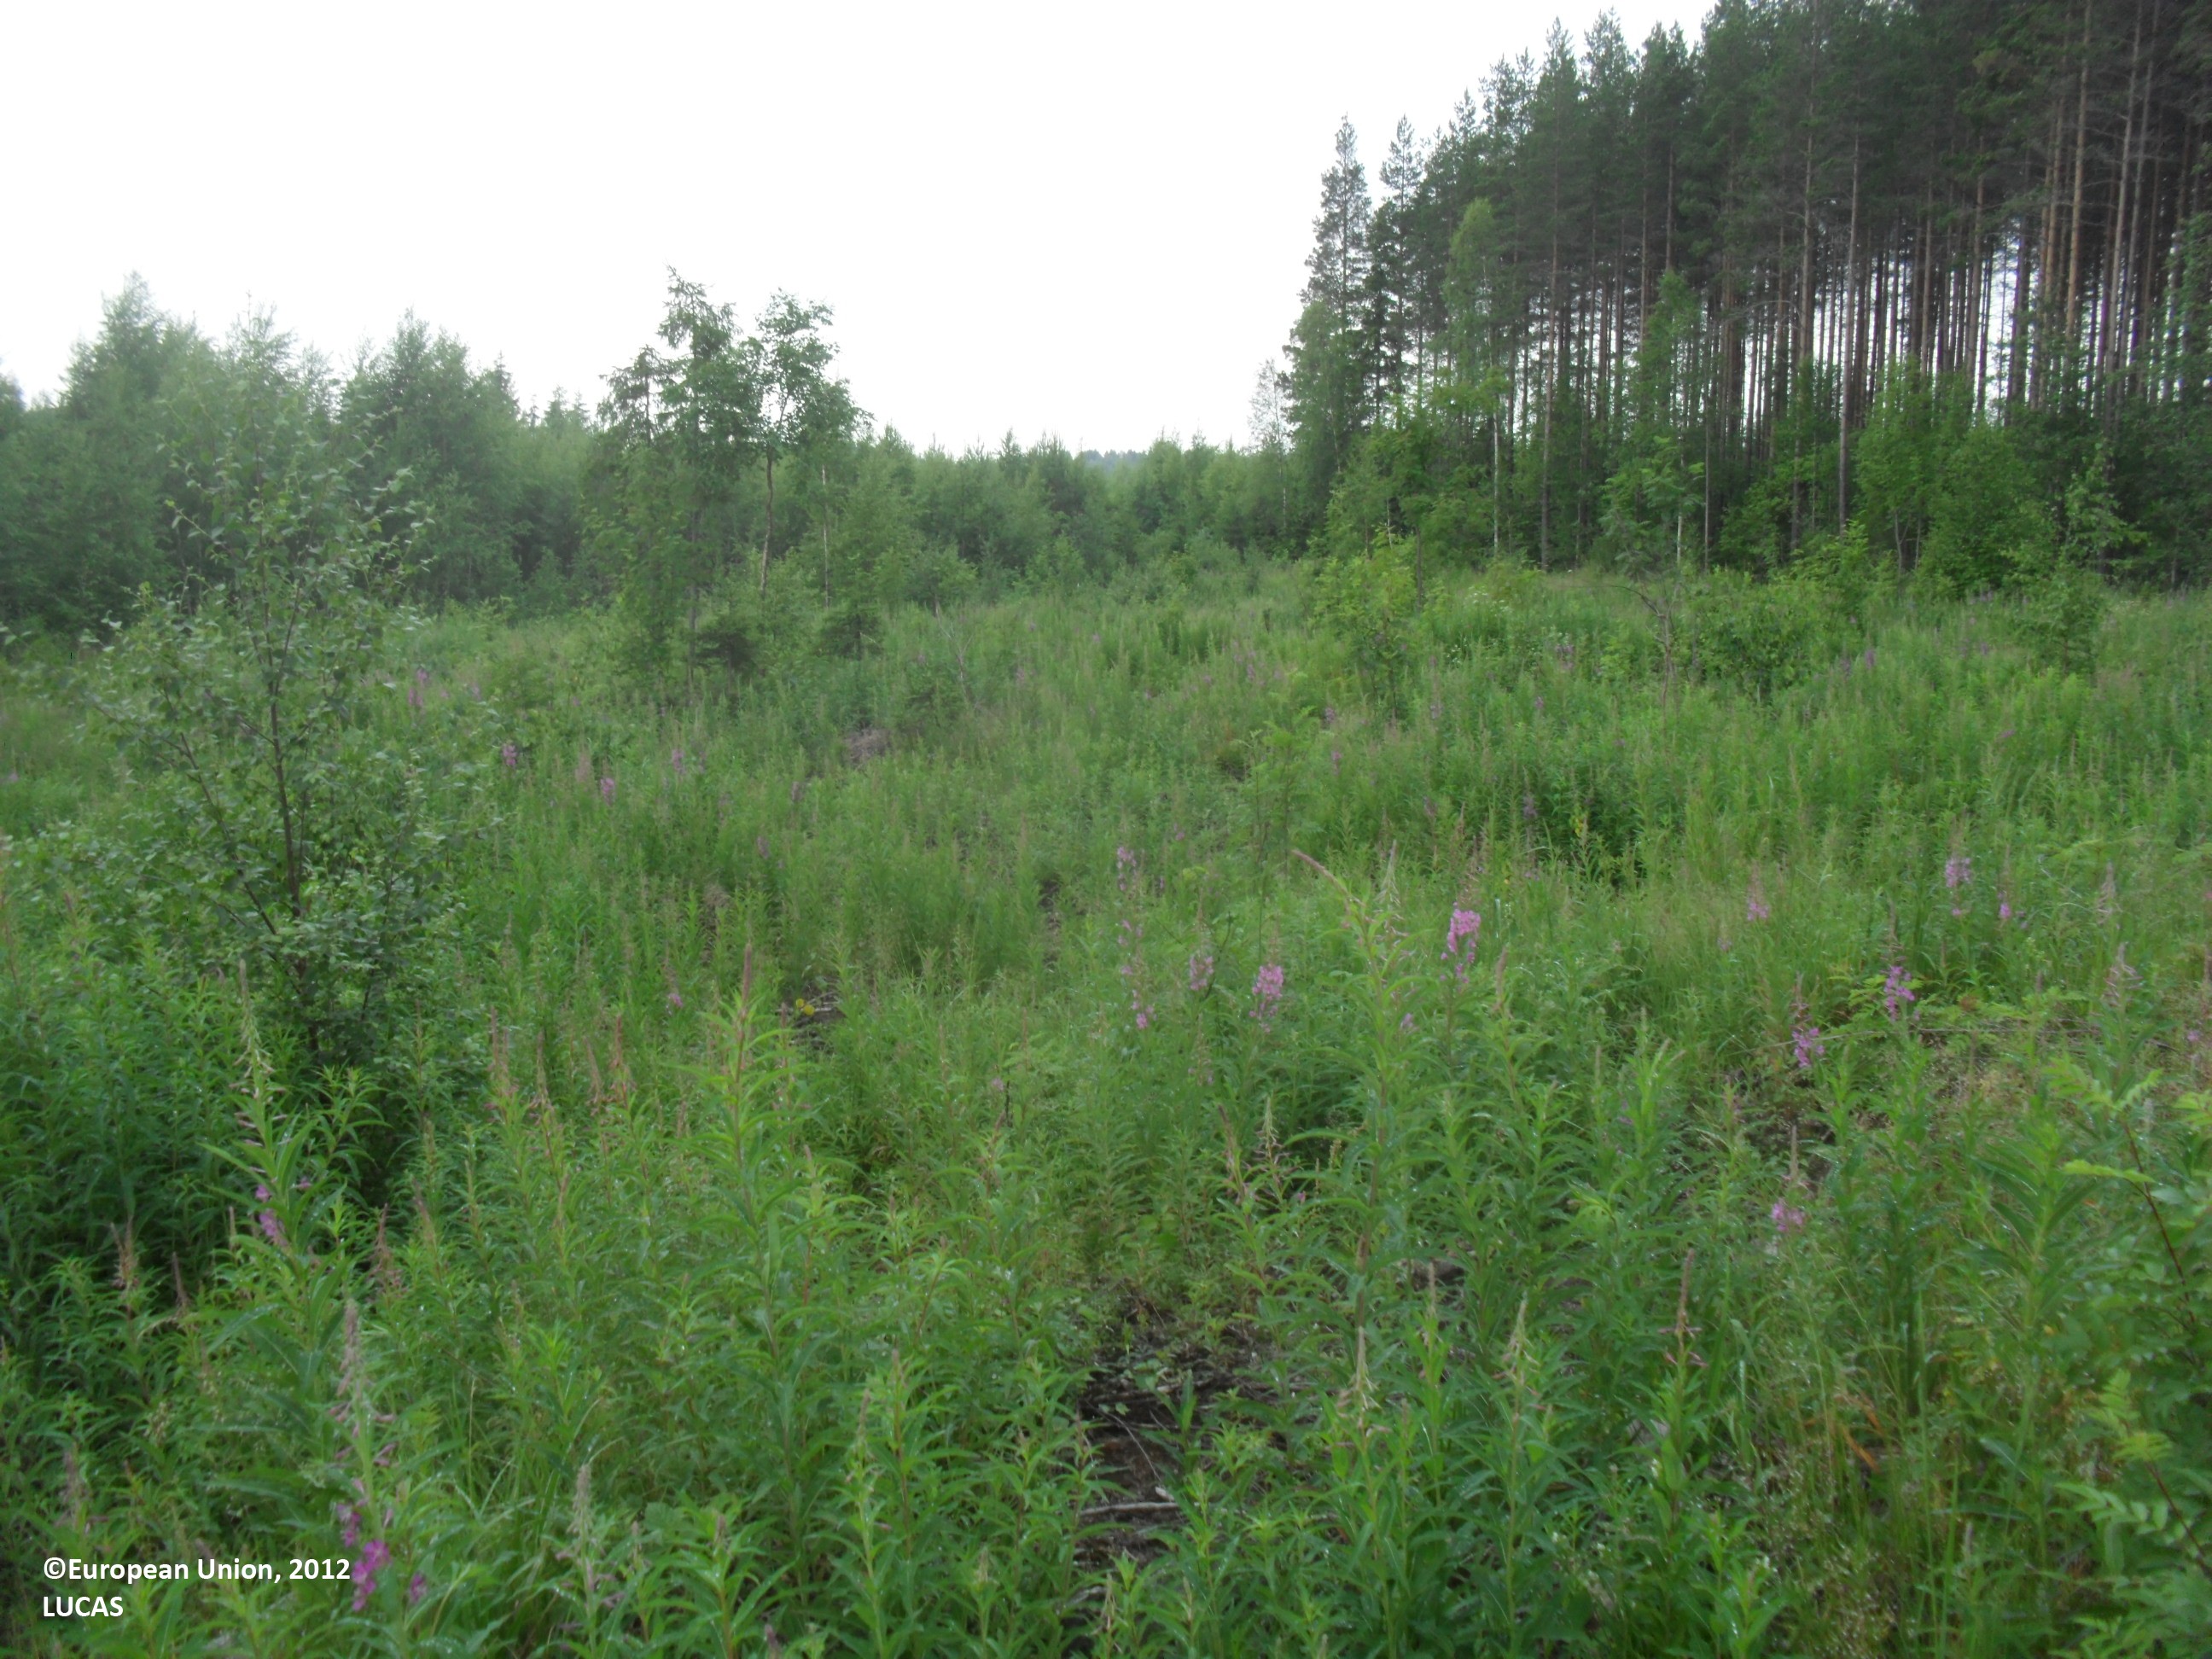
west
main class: Shrubland
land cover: Shrubland with sparse tree cover
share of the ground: 50 - 75 %
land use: Forestry
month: July
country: FI
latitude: 63.4352
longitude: 23.6743
